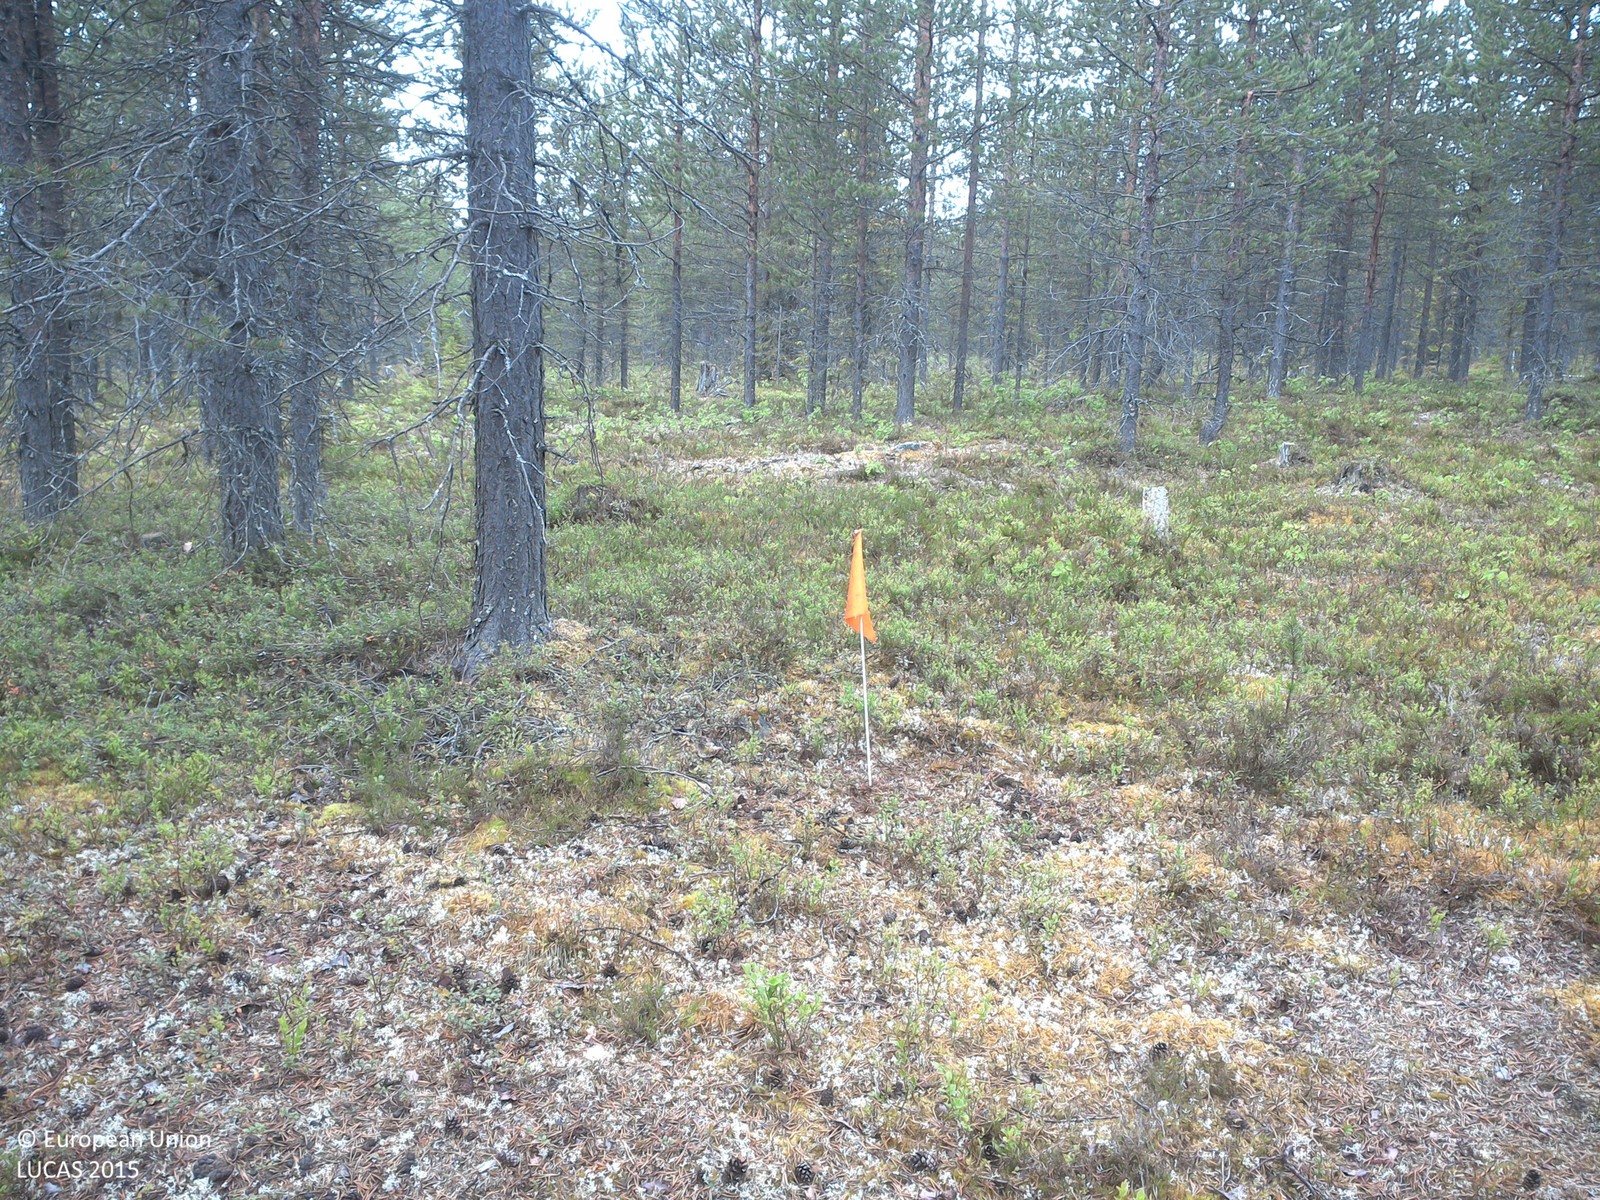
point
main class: Woodland
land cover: Pine dominated coniferous woodland
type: boreal forest
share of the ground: 25 - 50 %
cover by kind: lichens and mosses 35 %, coniferous forest trees 30 %, shrubs 30 %, broadleaved forest trees 5 %
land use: Forestry
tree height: > 5 m
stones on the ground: < 10 %
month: July
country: SE
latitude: 67.5767
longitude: 23.4757
